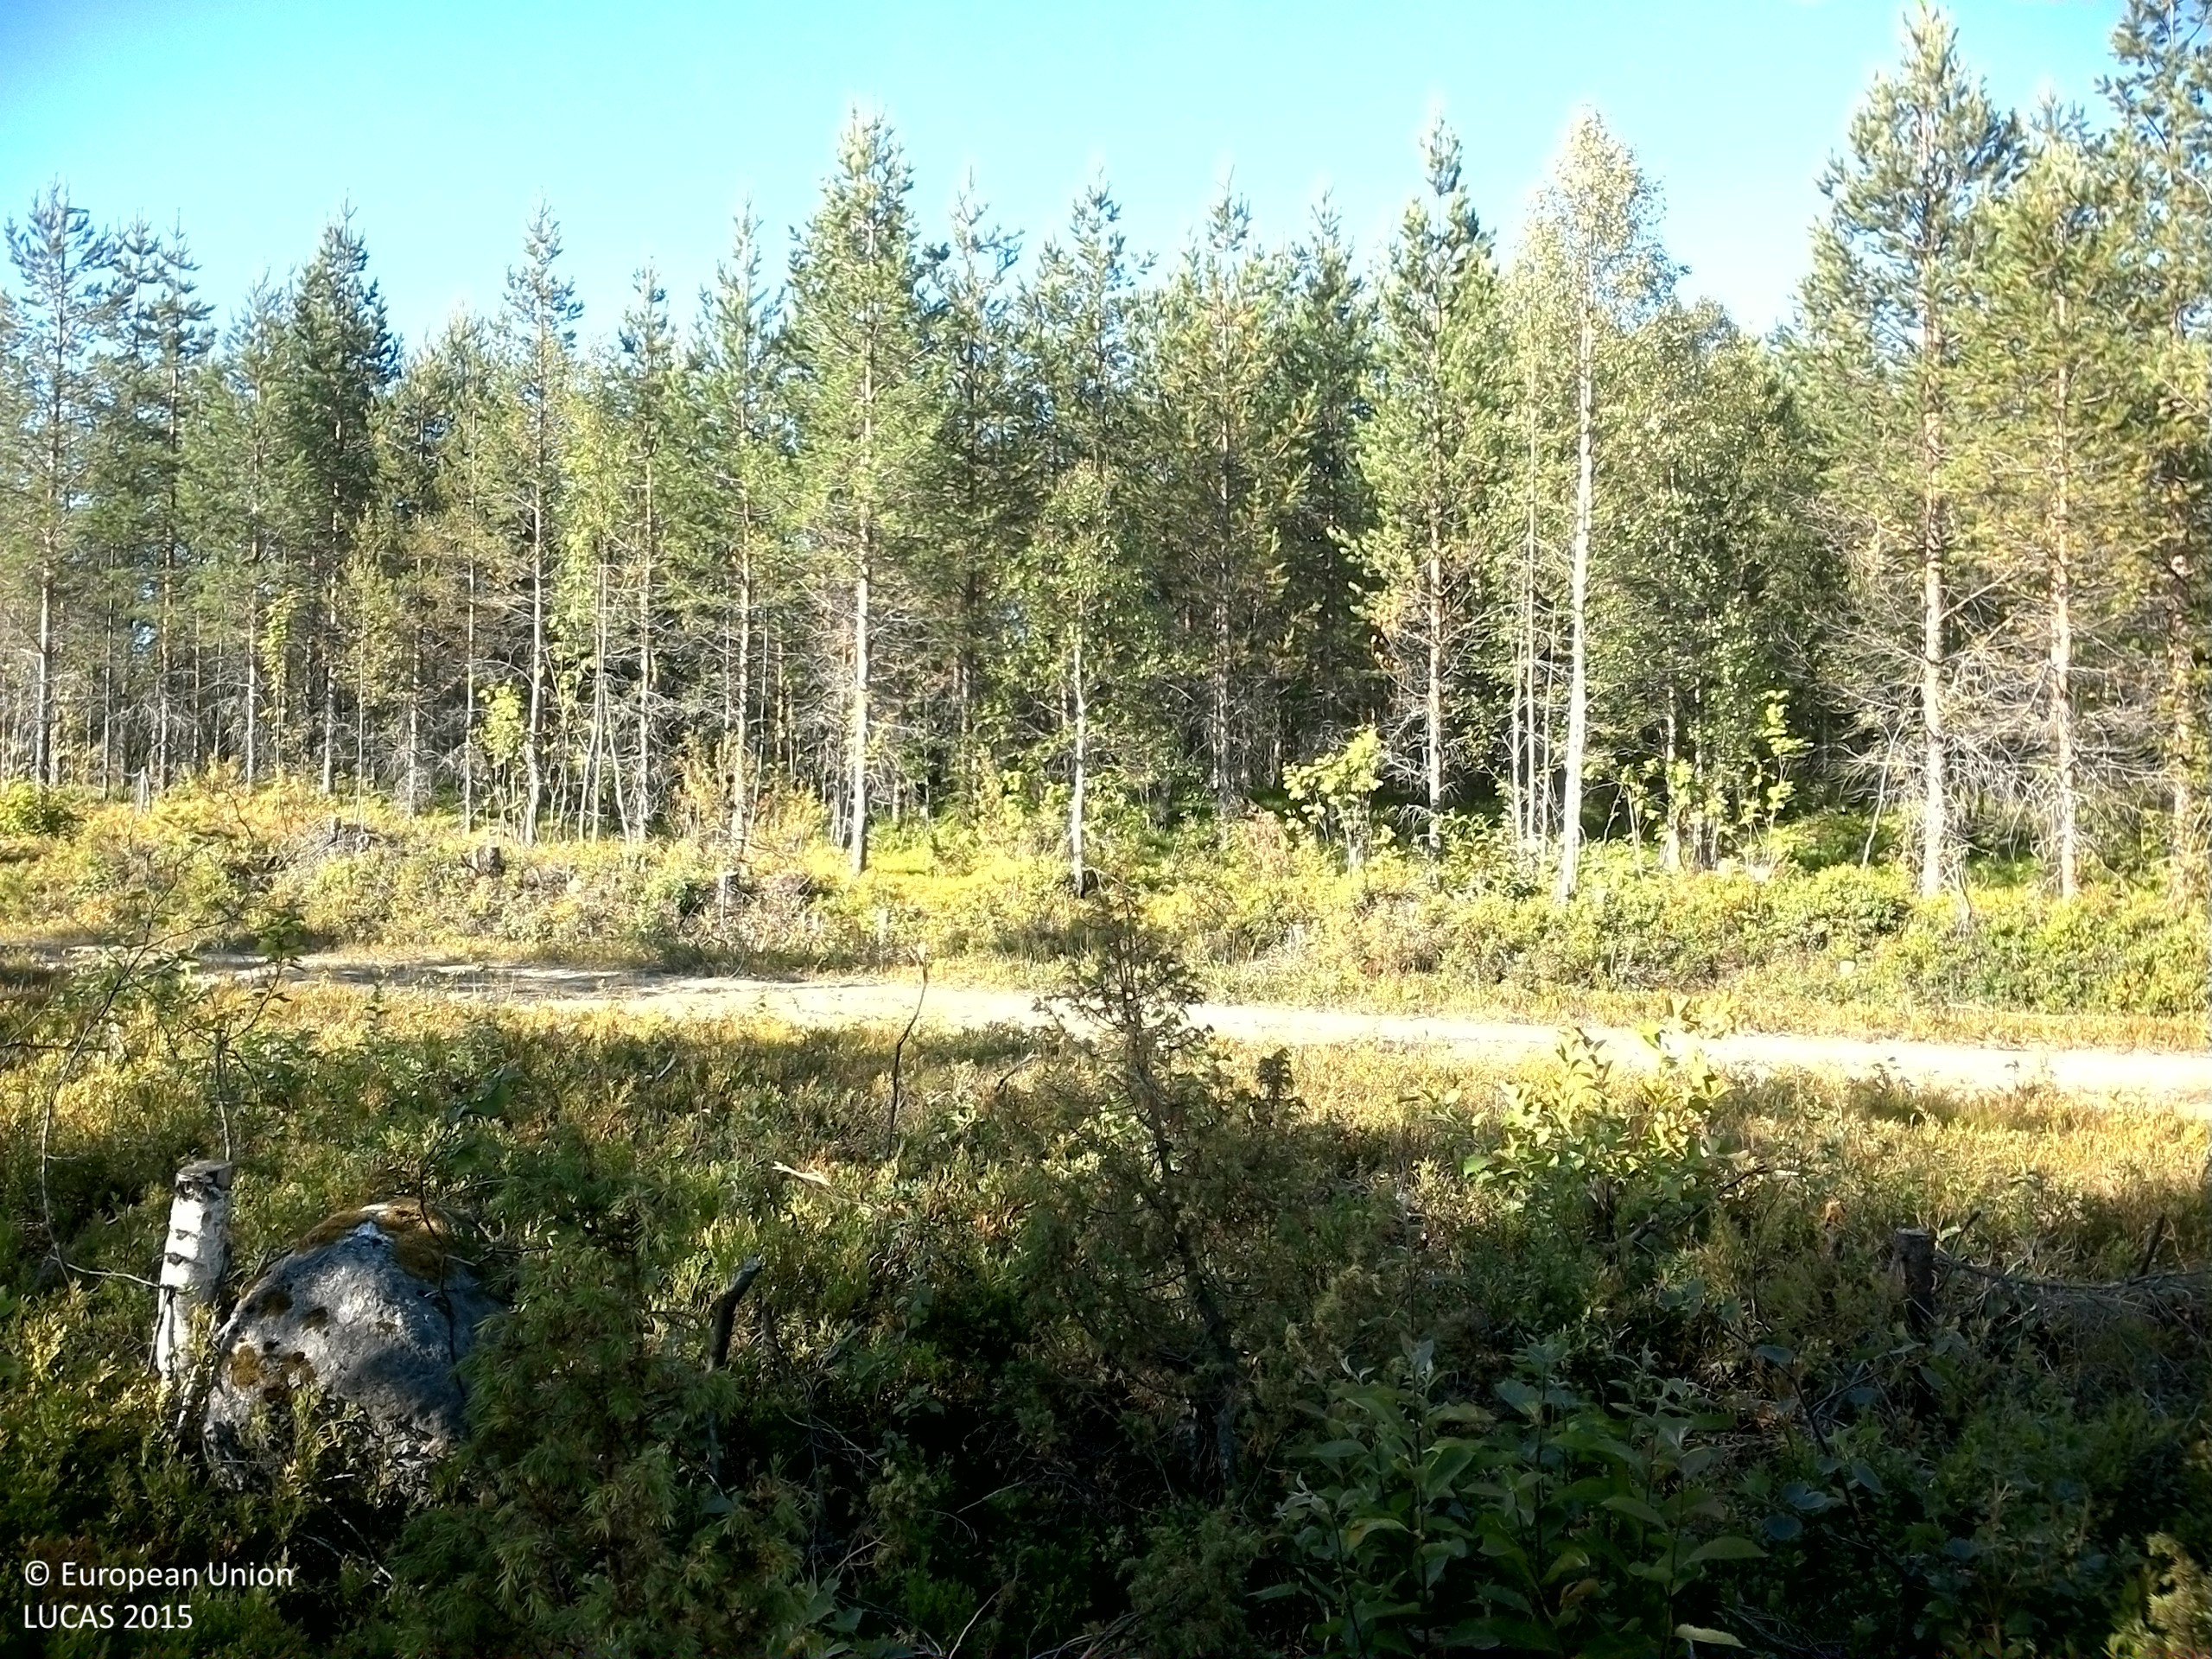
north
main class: Woodland
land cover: Other mixed woodland
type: boreal forest
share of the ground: > 75 %
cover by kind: coniferous forest trees 40 %, broadleaved forest trees 35 %, shrubs 25 %
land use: Forestry
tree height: < 5 m
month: August
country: SE
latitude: 63.8172
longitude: 17.5895
